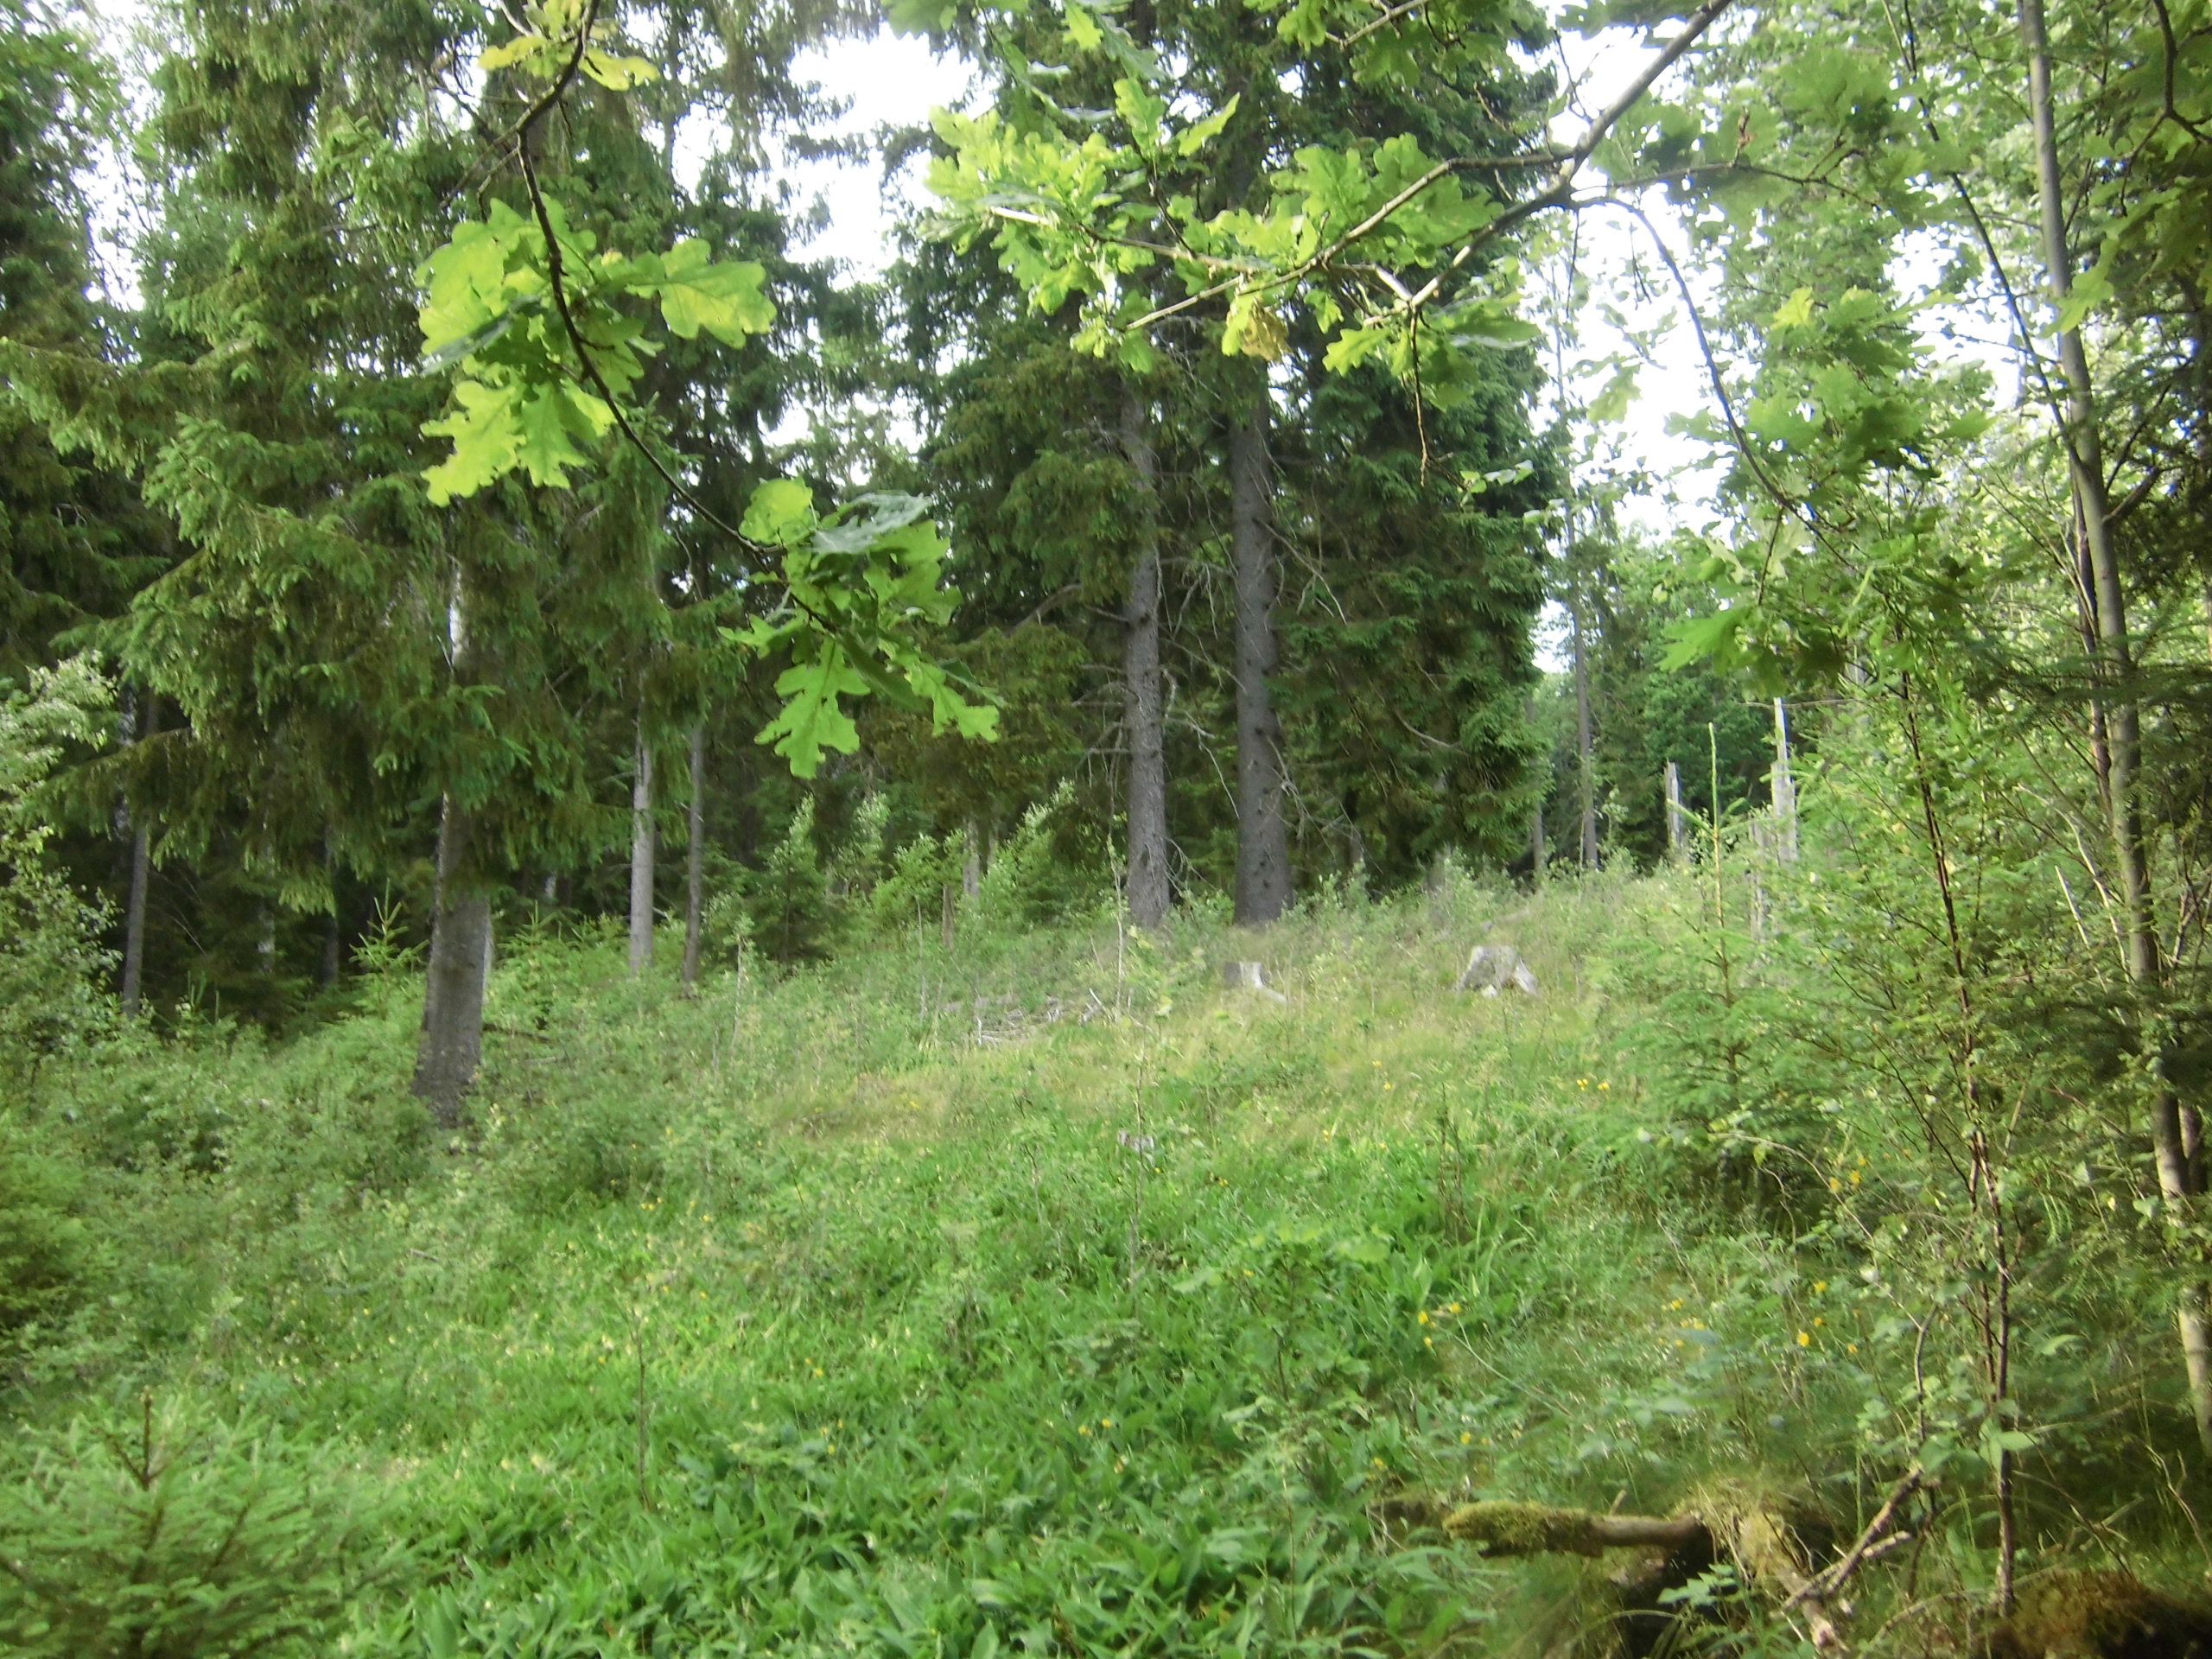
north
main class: Woodland
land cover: Spruce dominated mixed woodland
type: boreal forest
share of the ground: 50 - 75 %
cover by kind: coniferous forest trees 30 %, broadleaved forest trees 30 %, herbaceous plants 25 %, lichens and mosses 10 %, shrubs 5 %
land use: Forestry
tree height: > 5 m
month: July
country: SE
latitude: 57.2107
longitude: 14.9139
